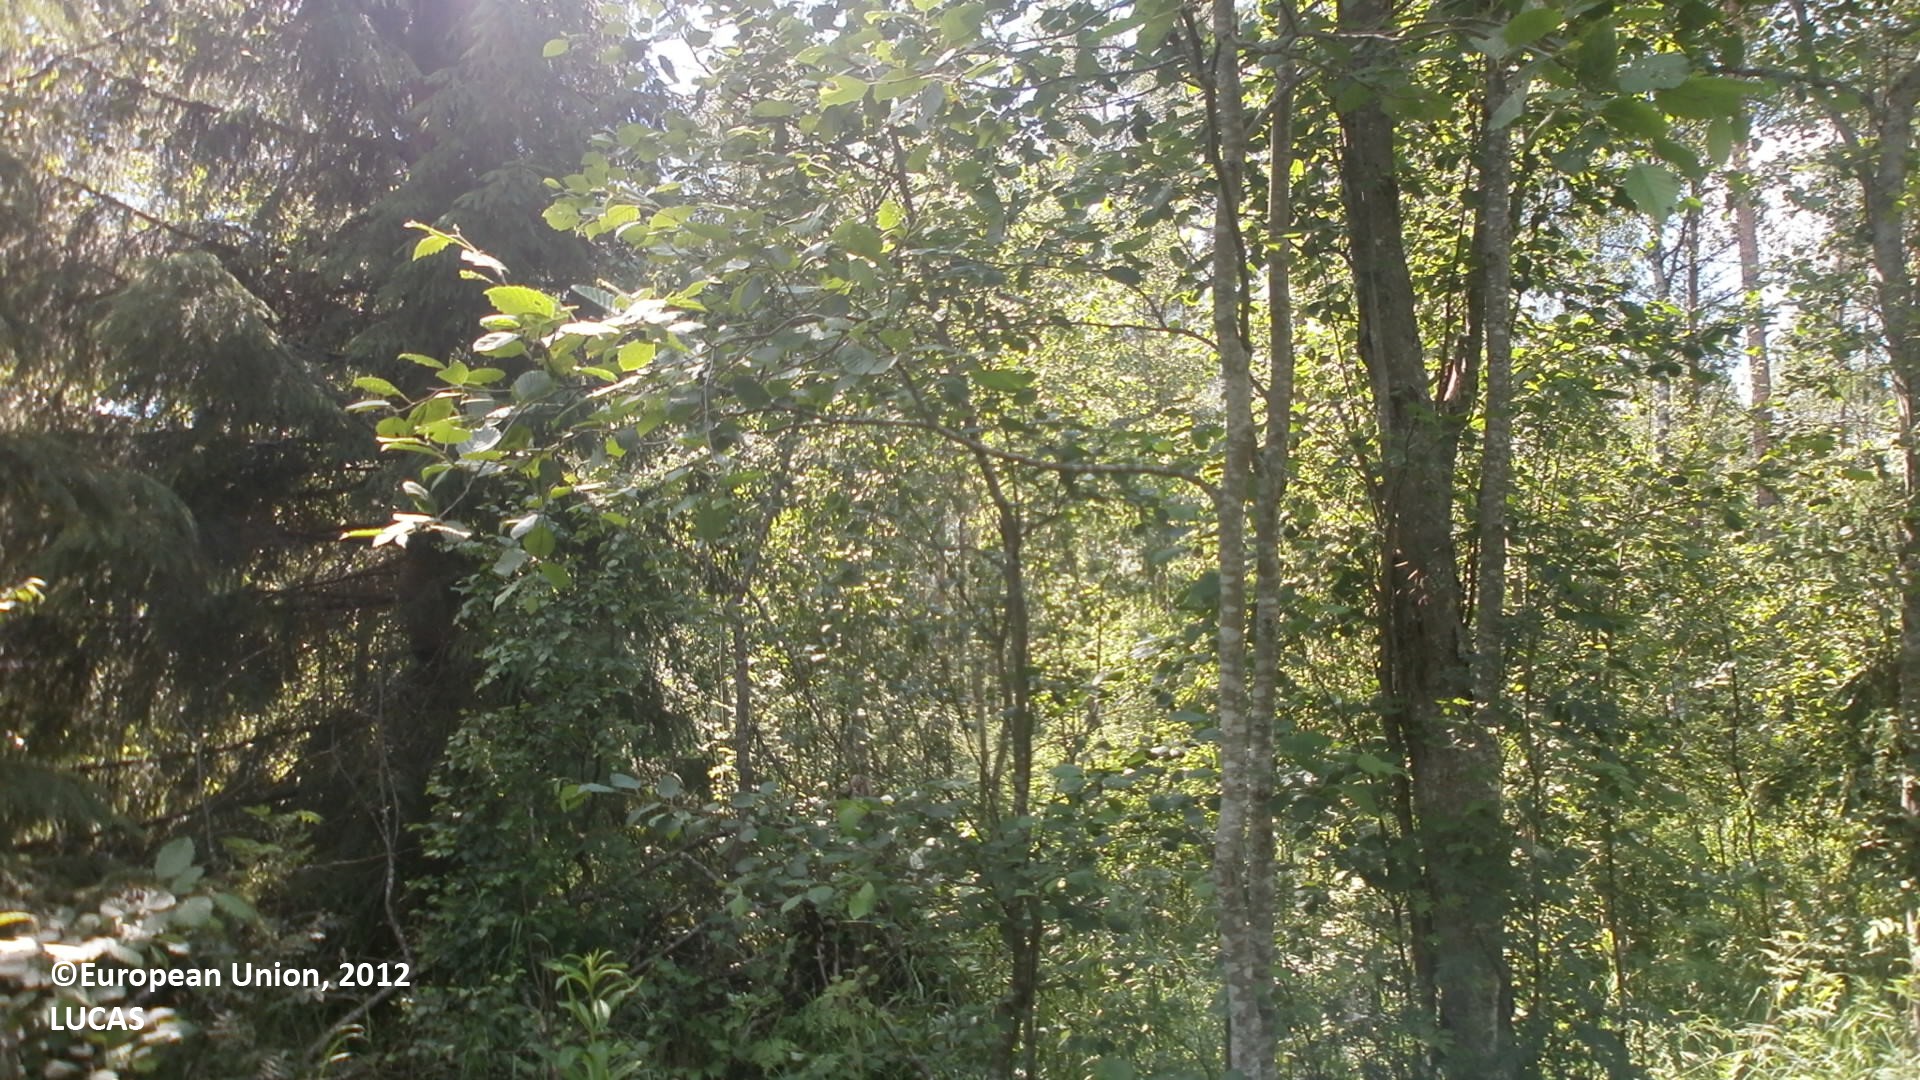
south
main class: Woodland
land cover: Spruce dominated mixed woodland
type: boreal forest
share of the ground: 50 - 75 %
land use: Forestry
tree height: > 5 m
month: July
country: FI
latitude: 64.4277
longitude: 24.5007
